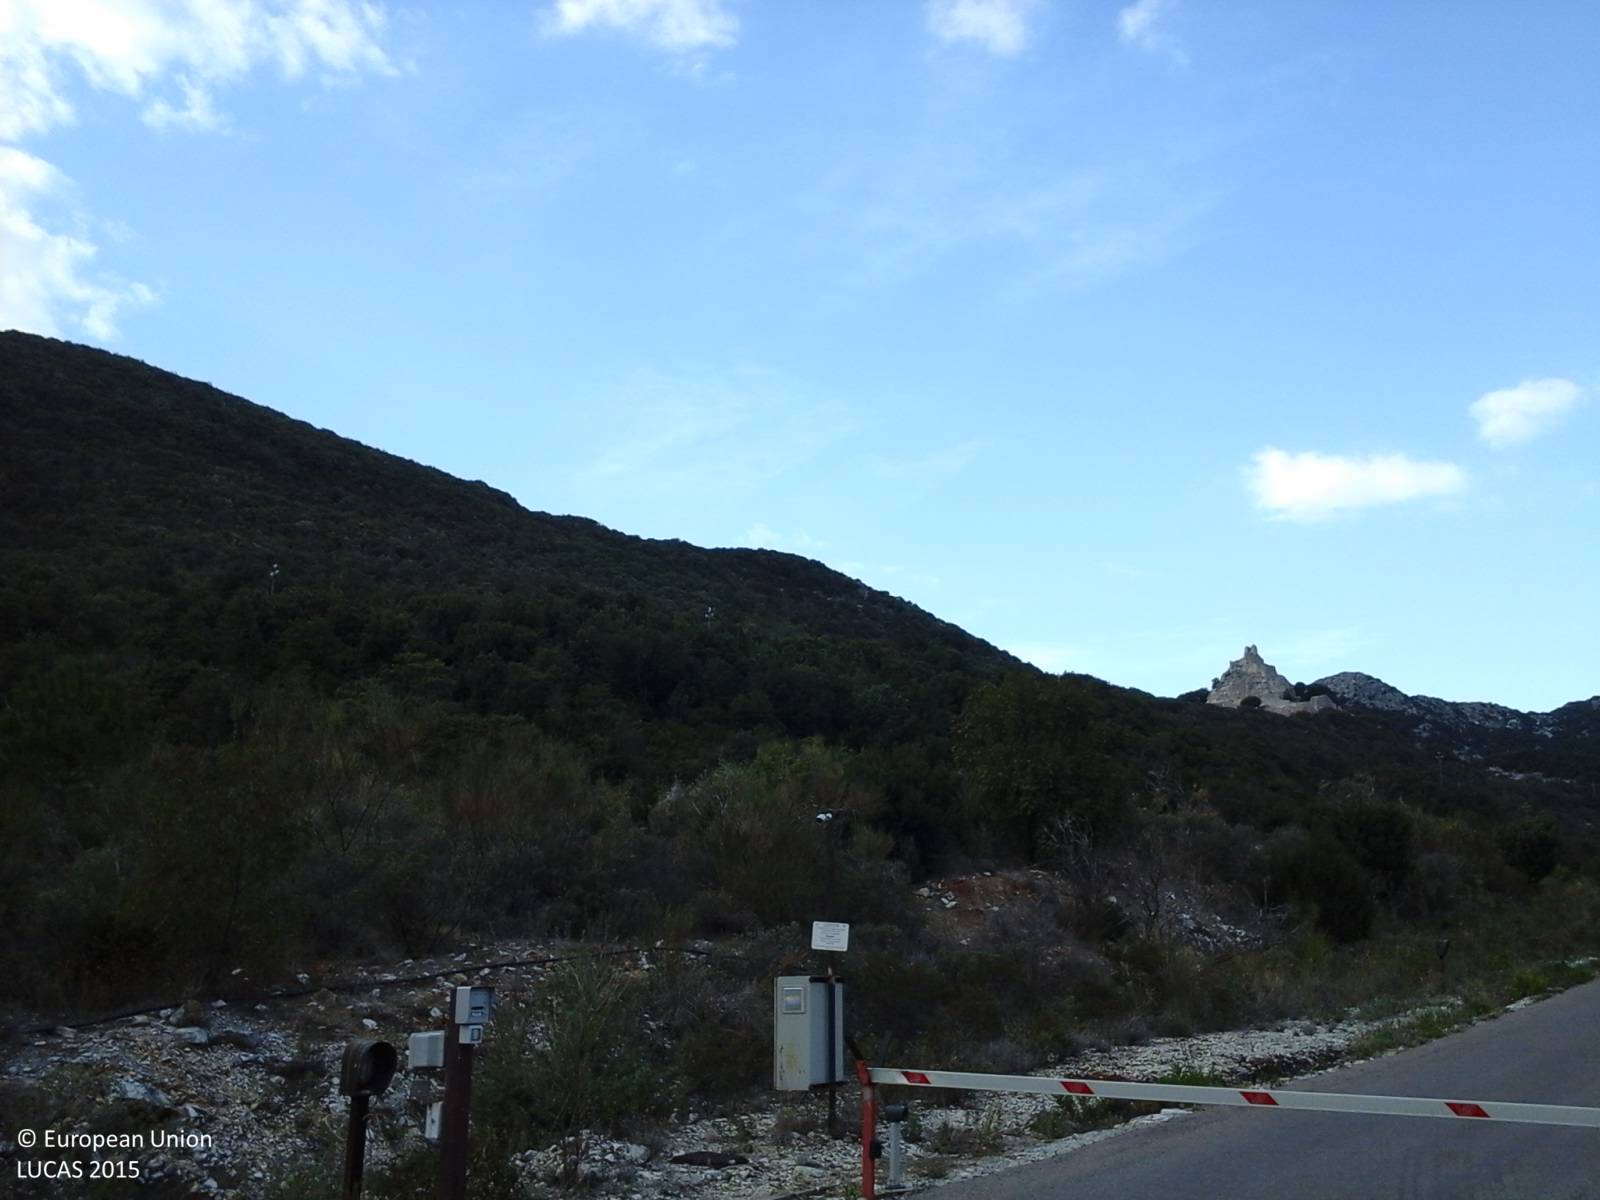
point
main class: Woodland
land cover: Broadleaved woodland
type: thermophilous deciduous forest
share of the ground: > 75 %
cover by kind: broadleaved forest trees 100 %
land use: Forestry
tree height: > 5 m
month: September
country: IT
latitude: 43.0856
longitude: 10.6000
